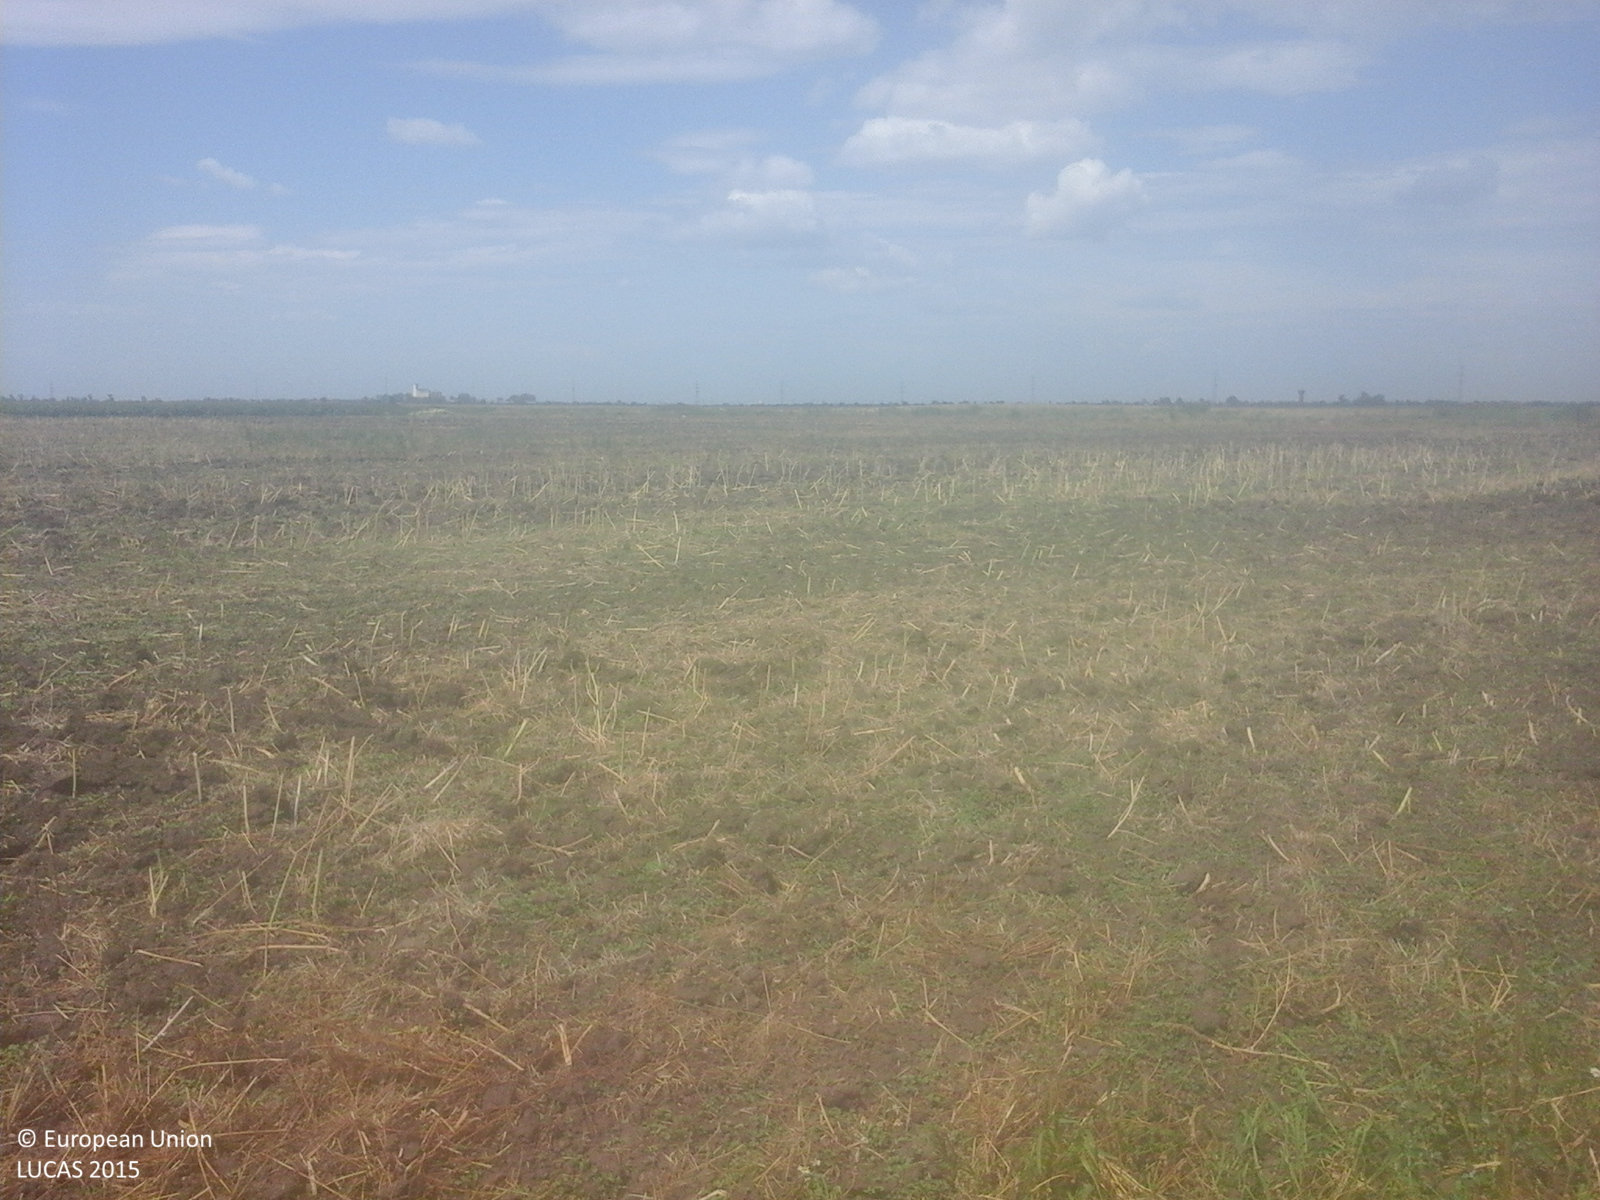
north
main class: Cropland
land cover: Rape and turnip rape
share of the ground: < 10 %
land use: Agriculture (excluding fallow land and kitchen gardens)
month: July
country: RO
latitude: 44.1238
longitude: 25.5478
